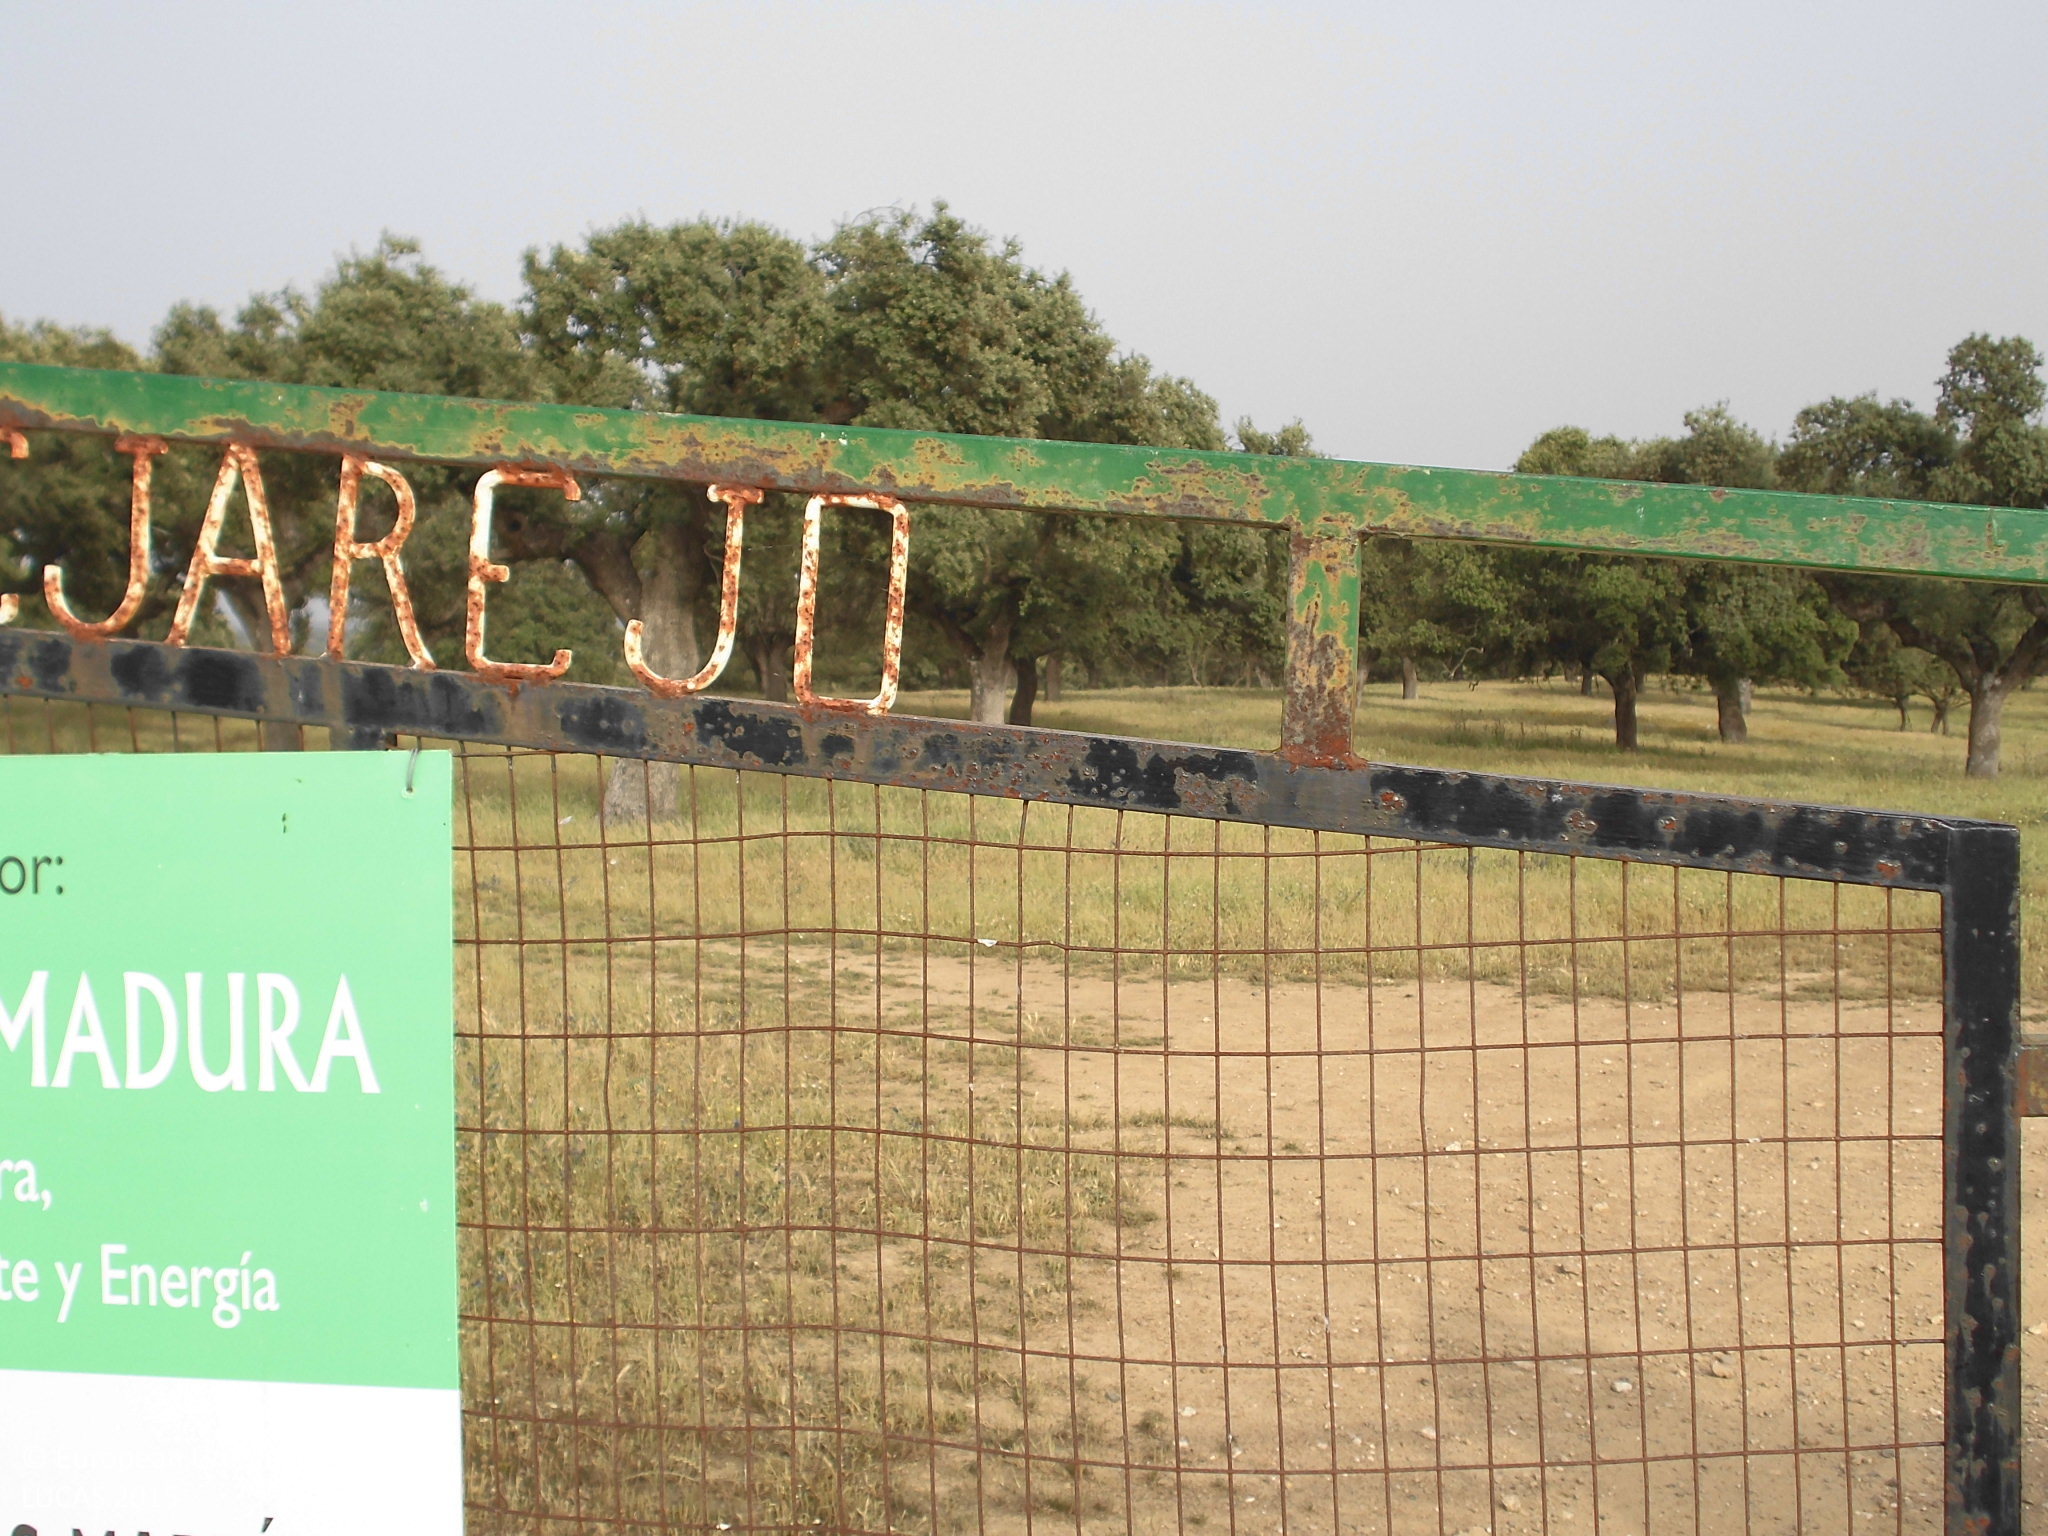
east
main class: Woodland
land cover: Broadleaved woodland
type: broadleaved evergreen forest
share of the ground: 25 - 50 %
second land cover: Grassland without tree/shrub cover
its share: > 75 %
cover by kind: broadleaved forest trees 45 %, herbaceous plants 40 %, shrubs 15 %
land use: Forestry
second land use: Agriculture (excluding fallow land and kitchen gardens)
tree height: > 5 m
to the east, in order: Broadleaved woodland; Grassland without tree/shrub cover; Rivers and streams; Broadleaved woodland
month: May
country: ES
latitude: 39.6260
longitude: -6.1073
